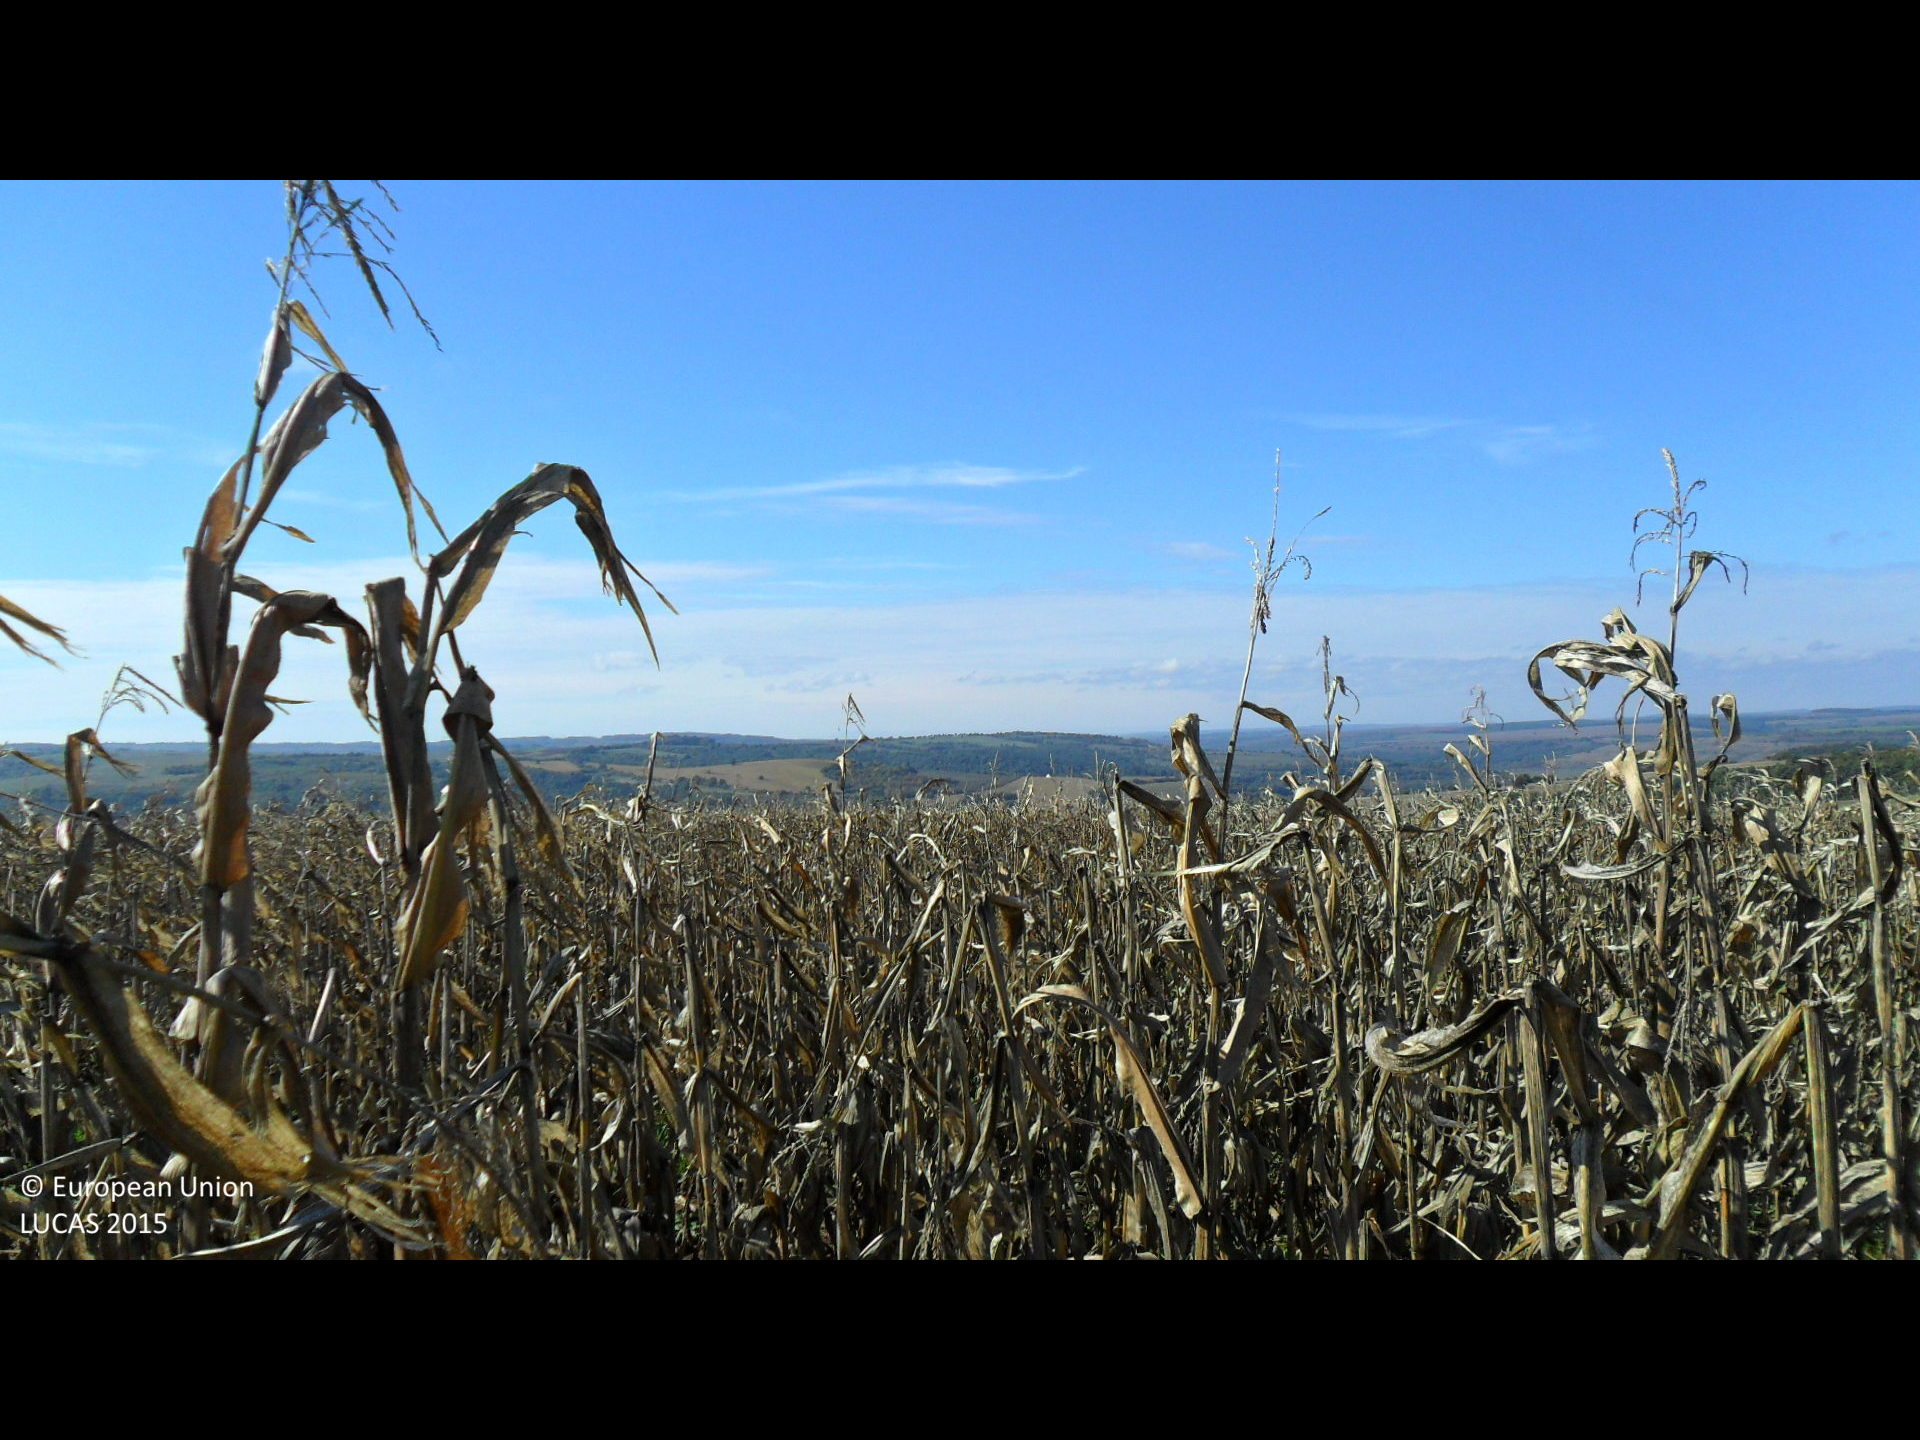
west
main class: Cropland
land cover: Maize
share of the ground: > 75 %
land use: Agriculture (excluding fallow land and kitchen gardens)
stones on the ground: < 10 %
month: October
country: BG
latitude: 43.2015
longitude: 26.2795
